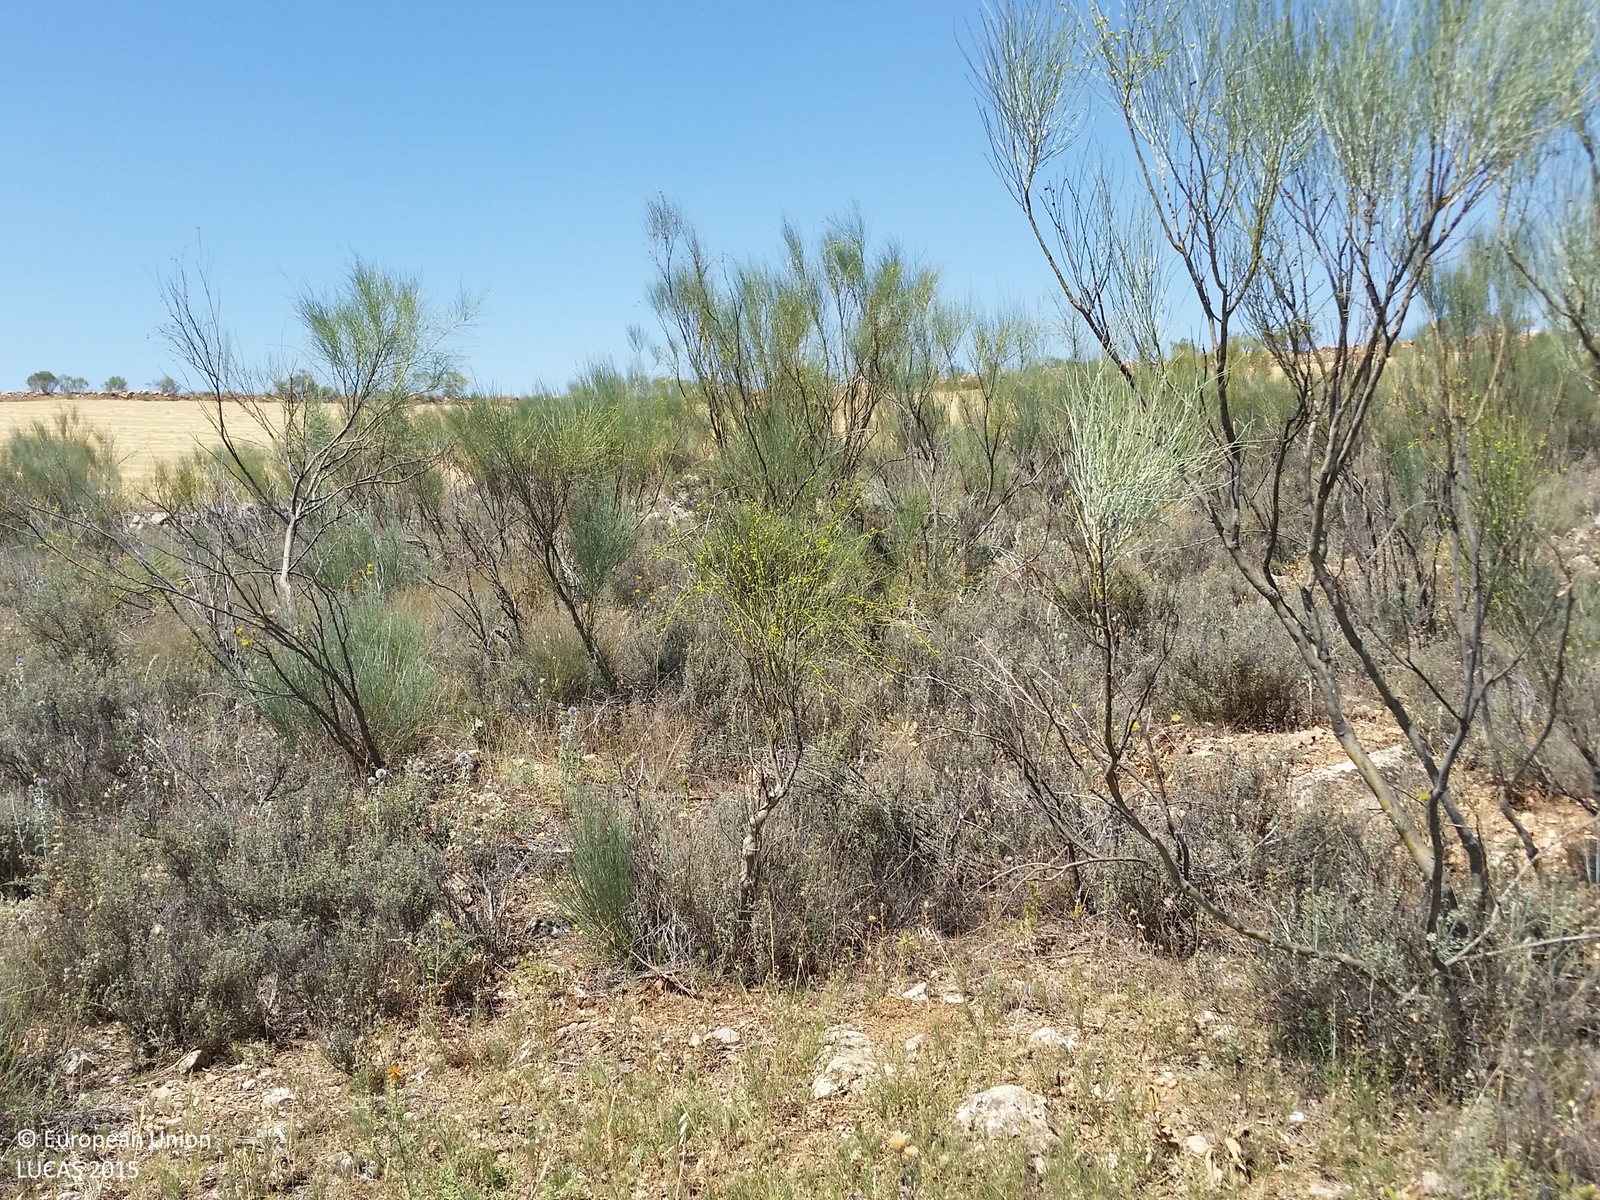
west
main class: Shrubland
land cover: Shrubland without tree cover
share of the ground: > 75 %
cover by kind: shrubs 75 %, consolidated bare surface 15 %, herbaceous plants 10 %
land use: Semi-natural and natural areas not in use
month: July
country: ES
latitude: 38.9759
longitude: -2.5994
